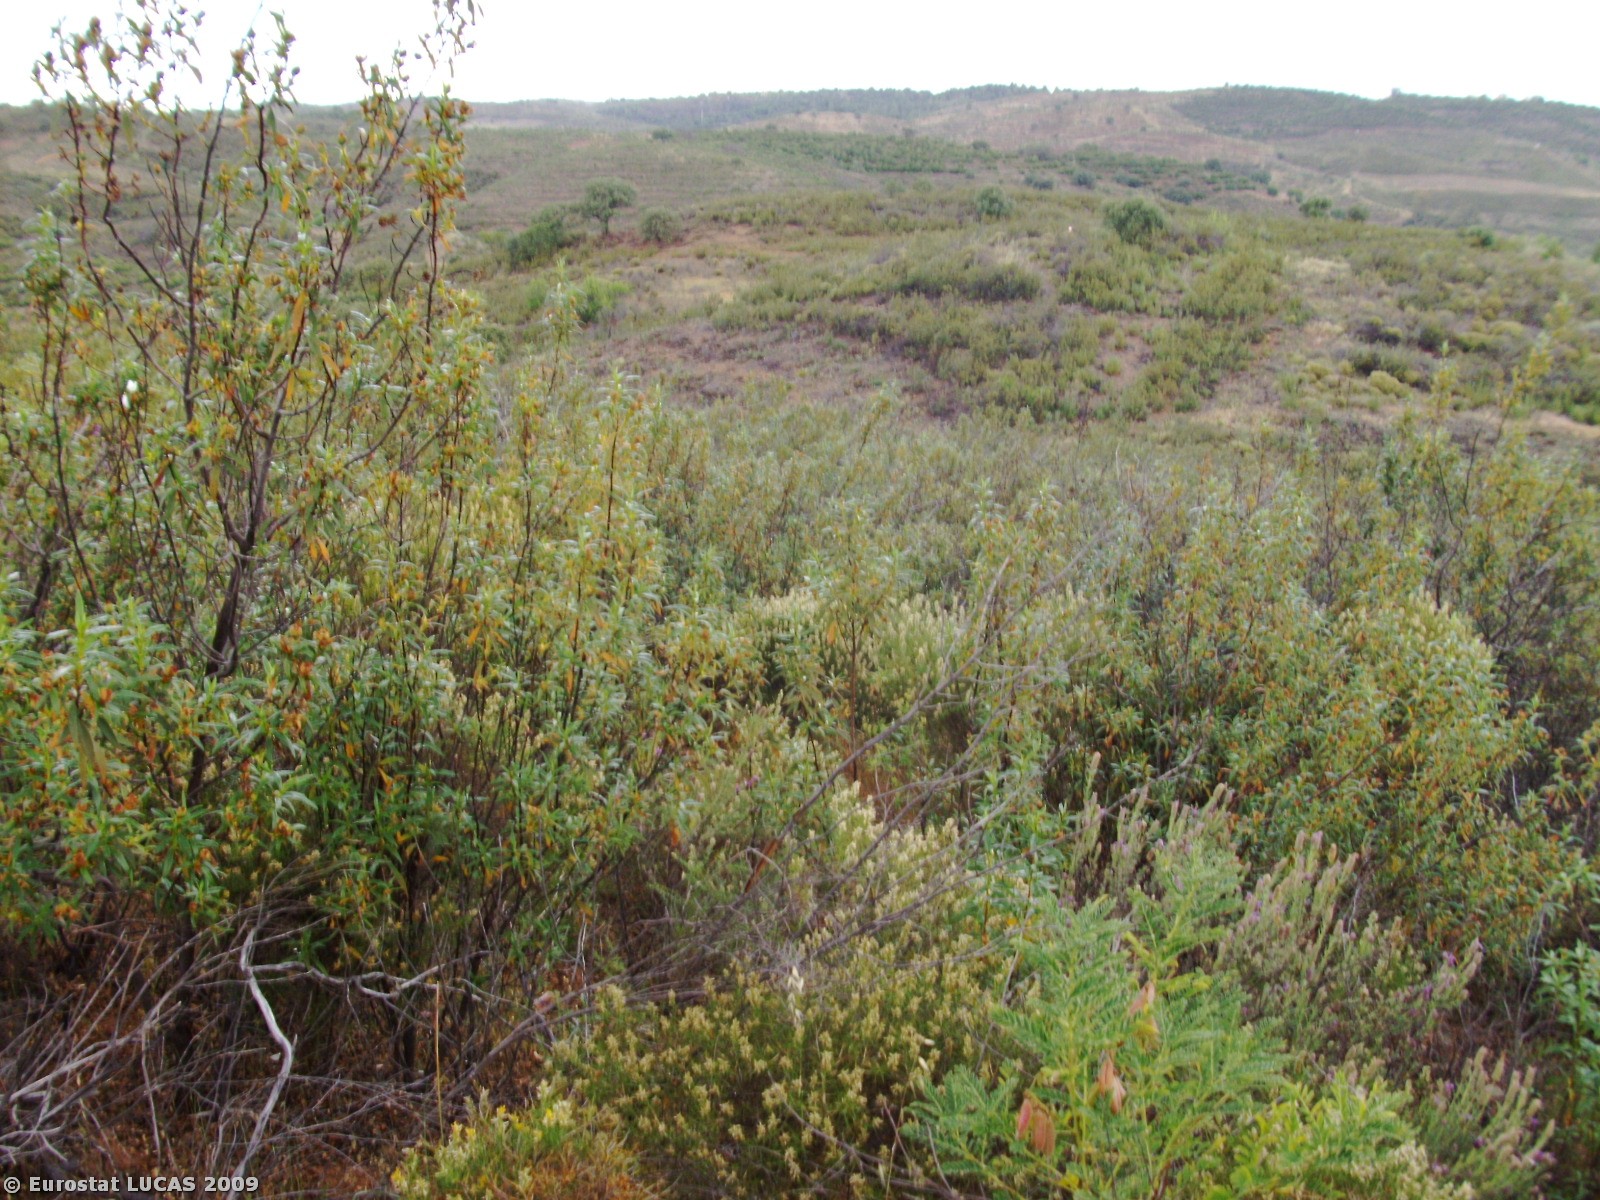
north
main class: Shrubland
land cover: Shrubland without tree cover
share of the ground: > 75 %
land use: Unused
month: April
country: PT
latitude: 37.2987
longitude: -7.4794
